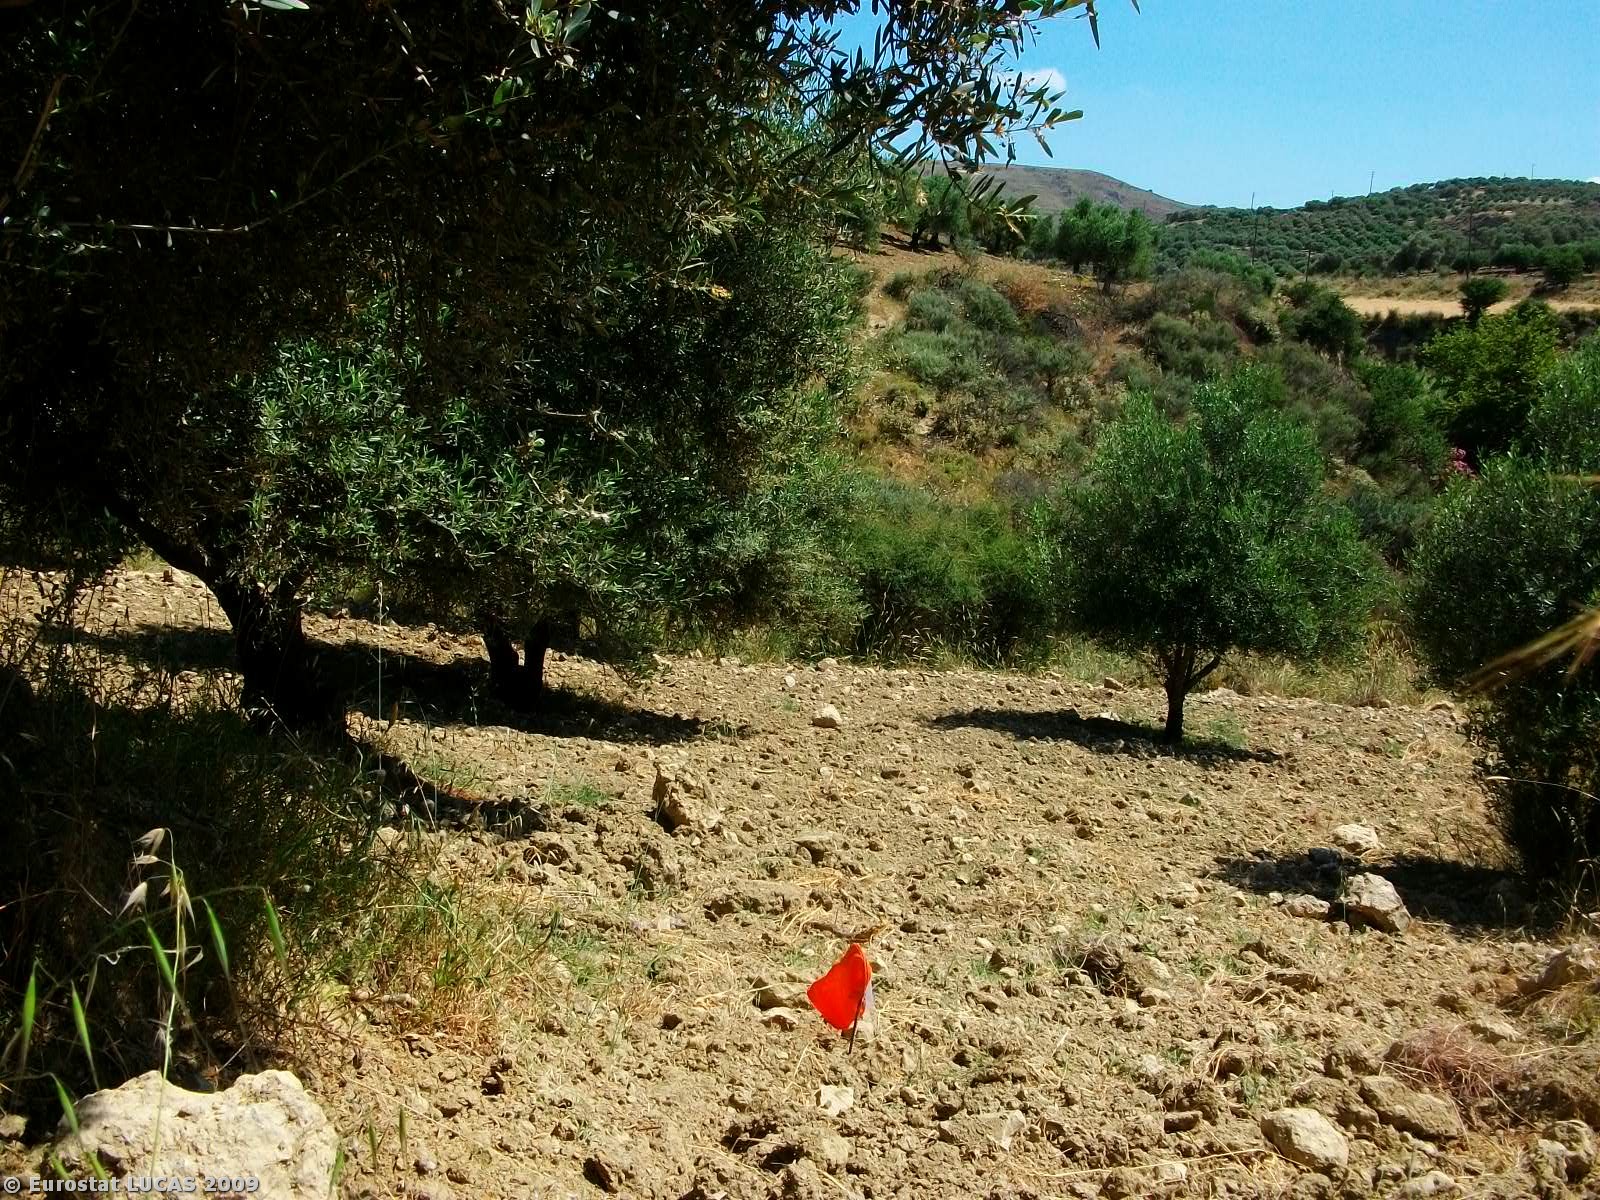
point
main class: Cropland
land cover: Olive groves
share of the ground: 50 - 75 %
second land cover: Bare land
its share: > 75 %
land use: Agriculture (excluding fallow land and kitchen gardens)
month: June
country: GR
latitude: 35.0833
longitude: 24.9574
